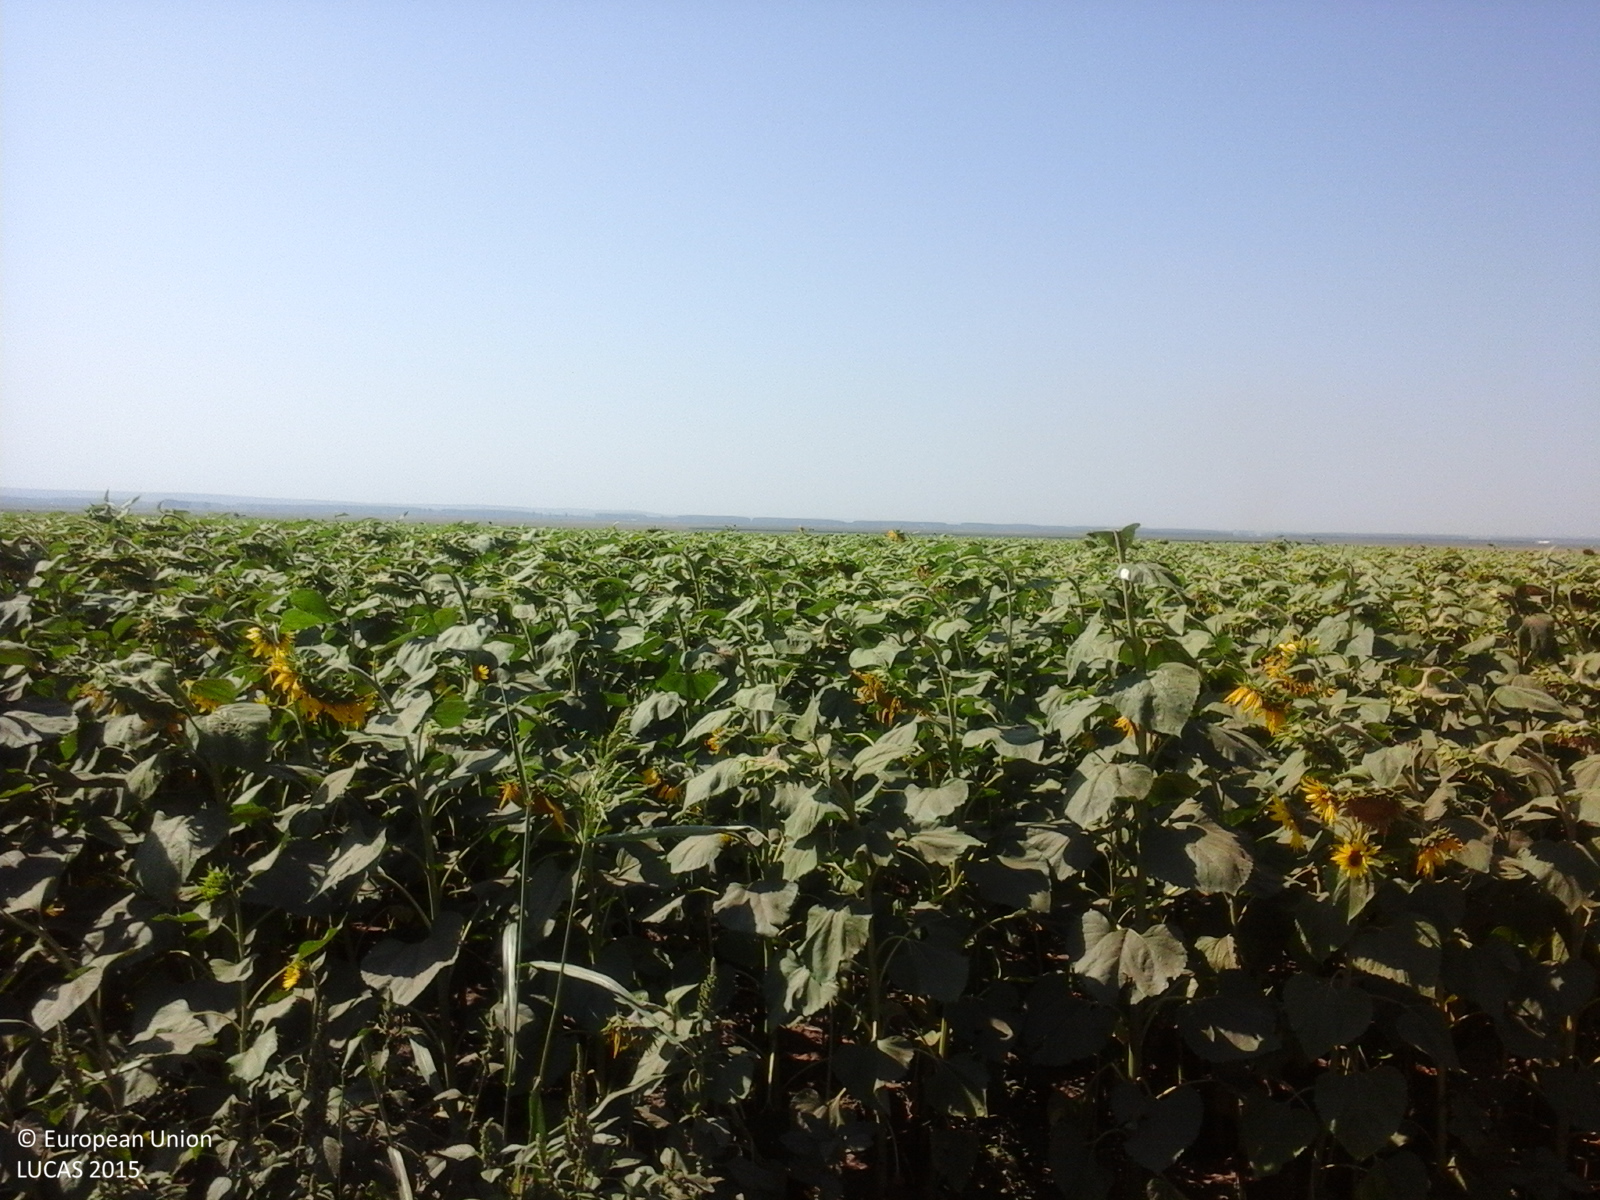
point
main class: Cropland
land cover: Sunflower
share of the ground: > 75 %
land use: Agriculture (excluding fallow land and kitchen gardens)
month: July
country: RO
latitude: 44.2735
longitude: 27.4664
